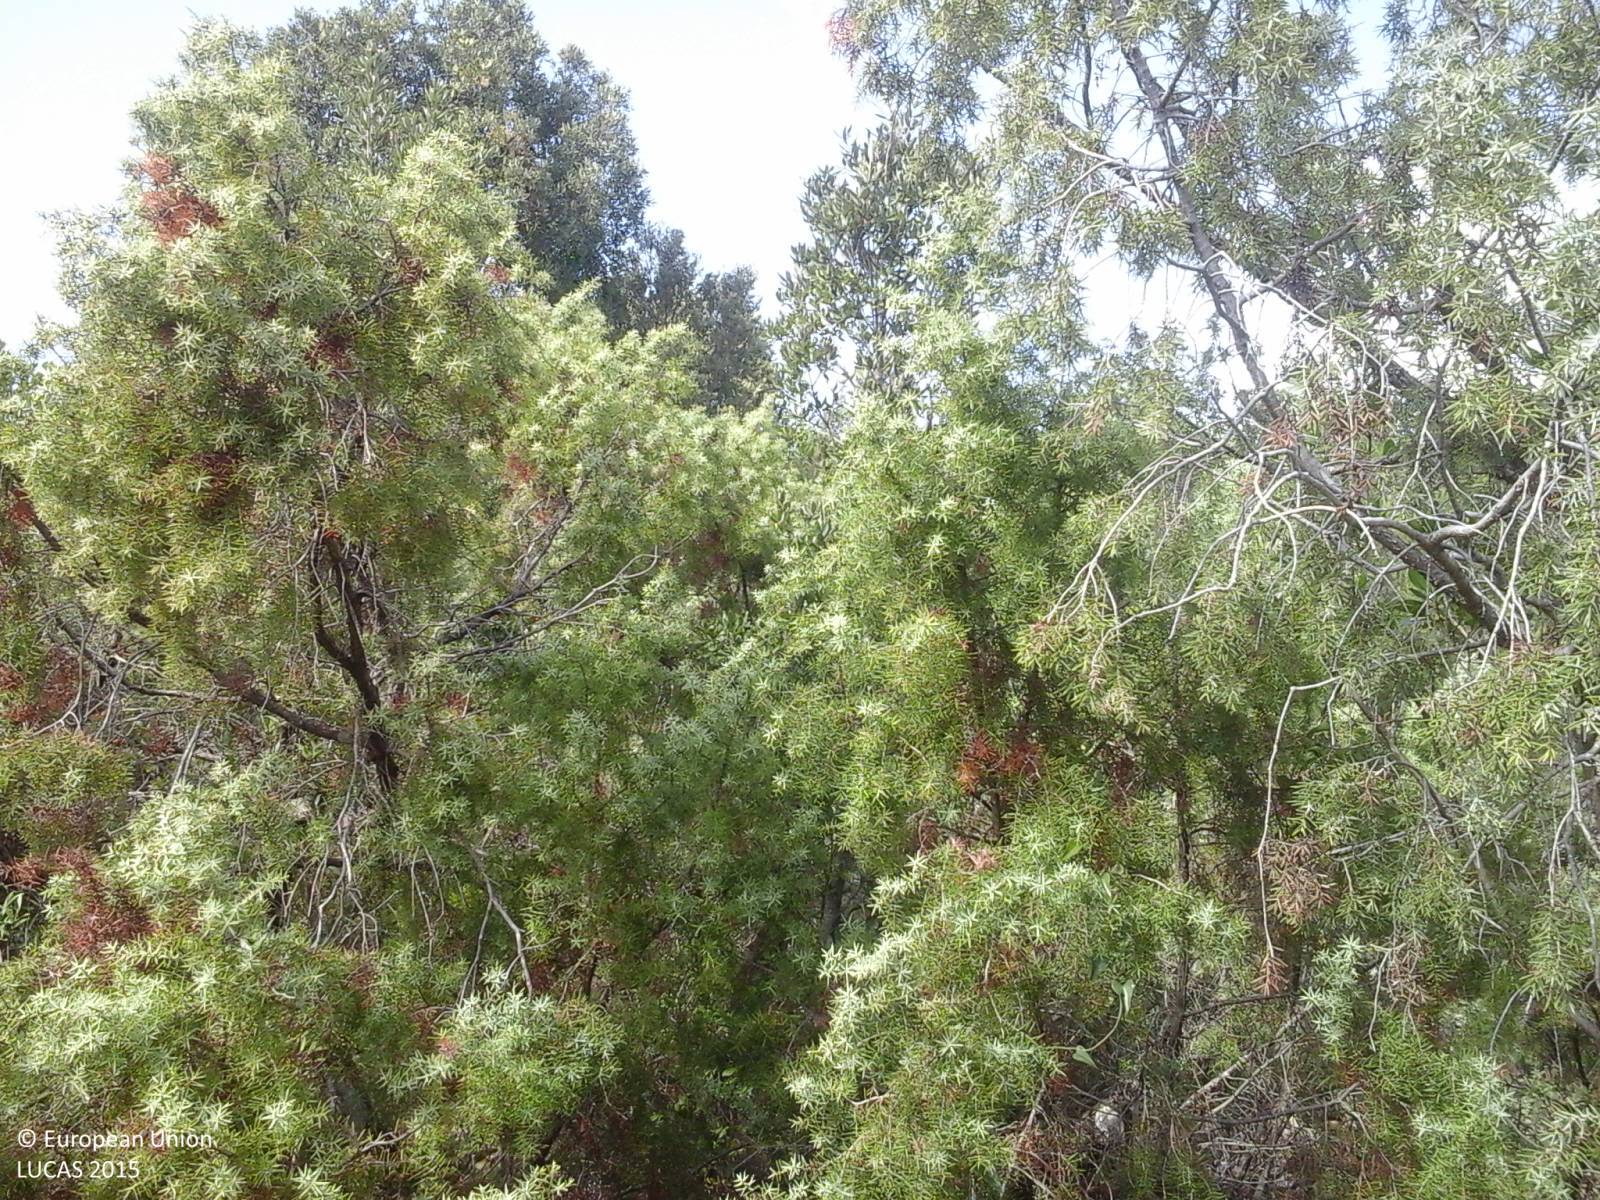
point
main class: Woodland
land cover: Broadleaved woodland
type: broadleaved evergreen forest
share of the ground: > 75 %
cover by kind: broadleaved forest trees 80 %, shrubs 15 %, herbaceous plants 5 %
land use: Semi-natural and natural areas not in use
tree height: > 5 m
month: September
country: IT
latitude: 39.8131
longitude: 9.4541
